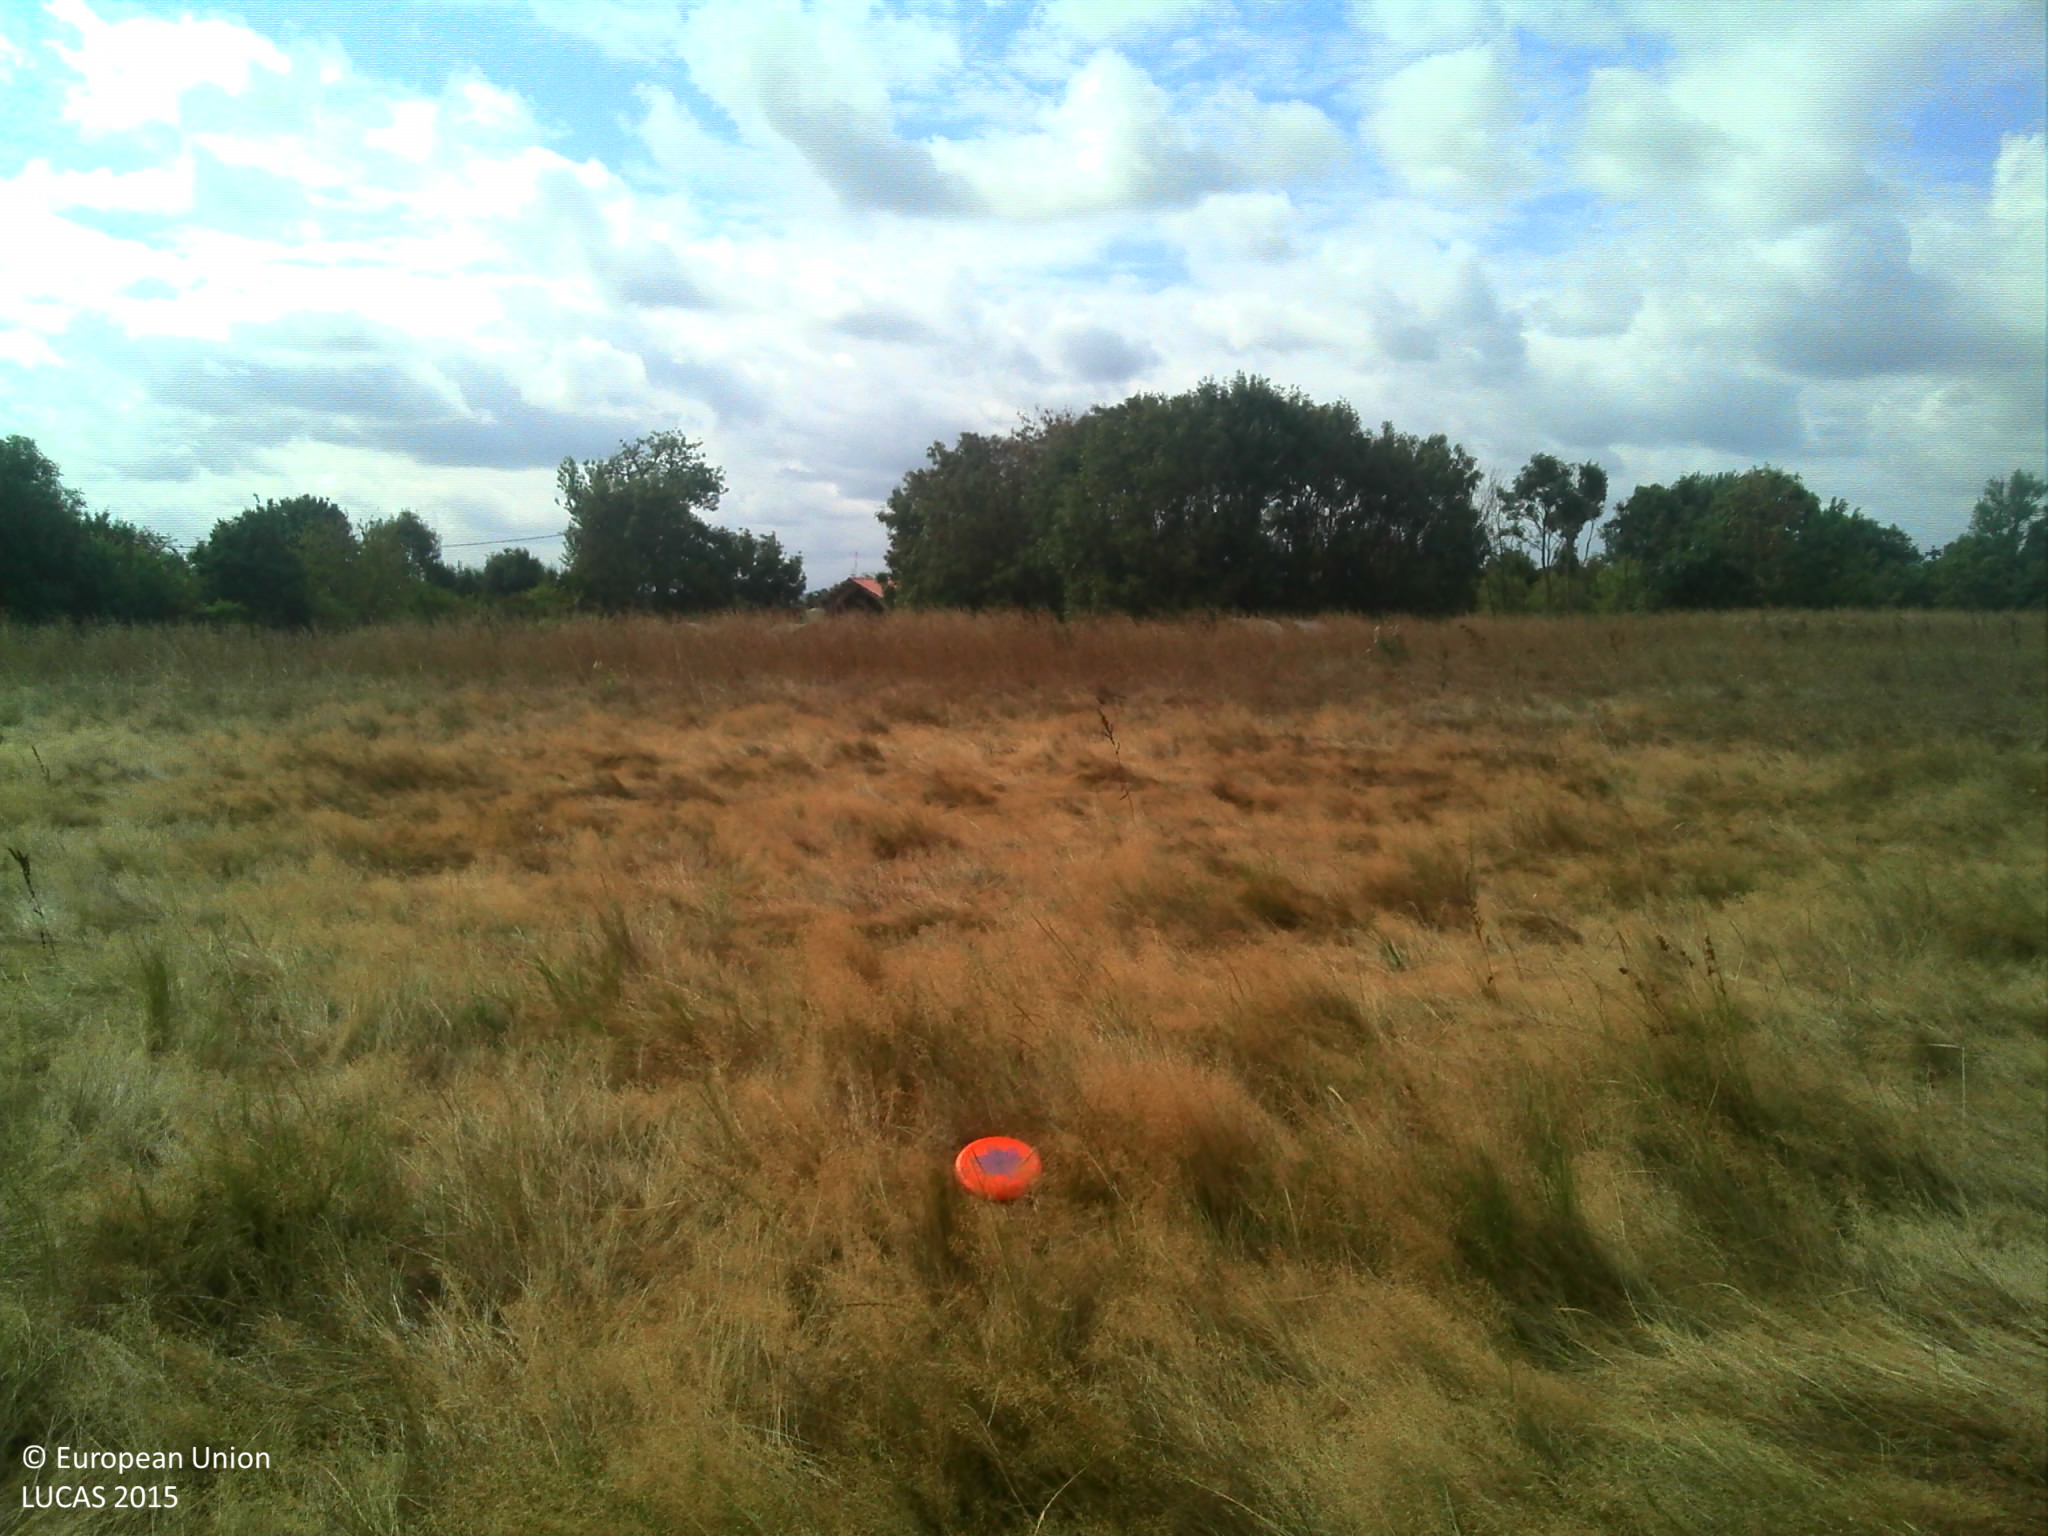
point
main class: Grassland
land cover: Grassland without tree/shrub cover
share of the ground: > 75 %
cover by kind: herbaceous plants 100 %
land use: Agriculture (excluding fallow land and kitchen gardens)
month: July
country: FR
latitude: 43.2418
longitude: 1.0992
